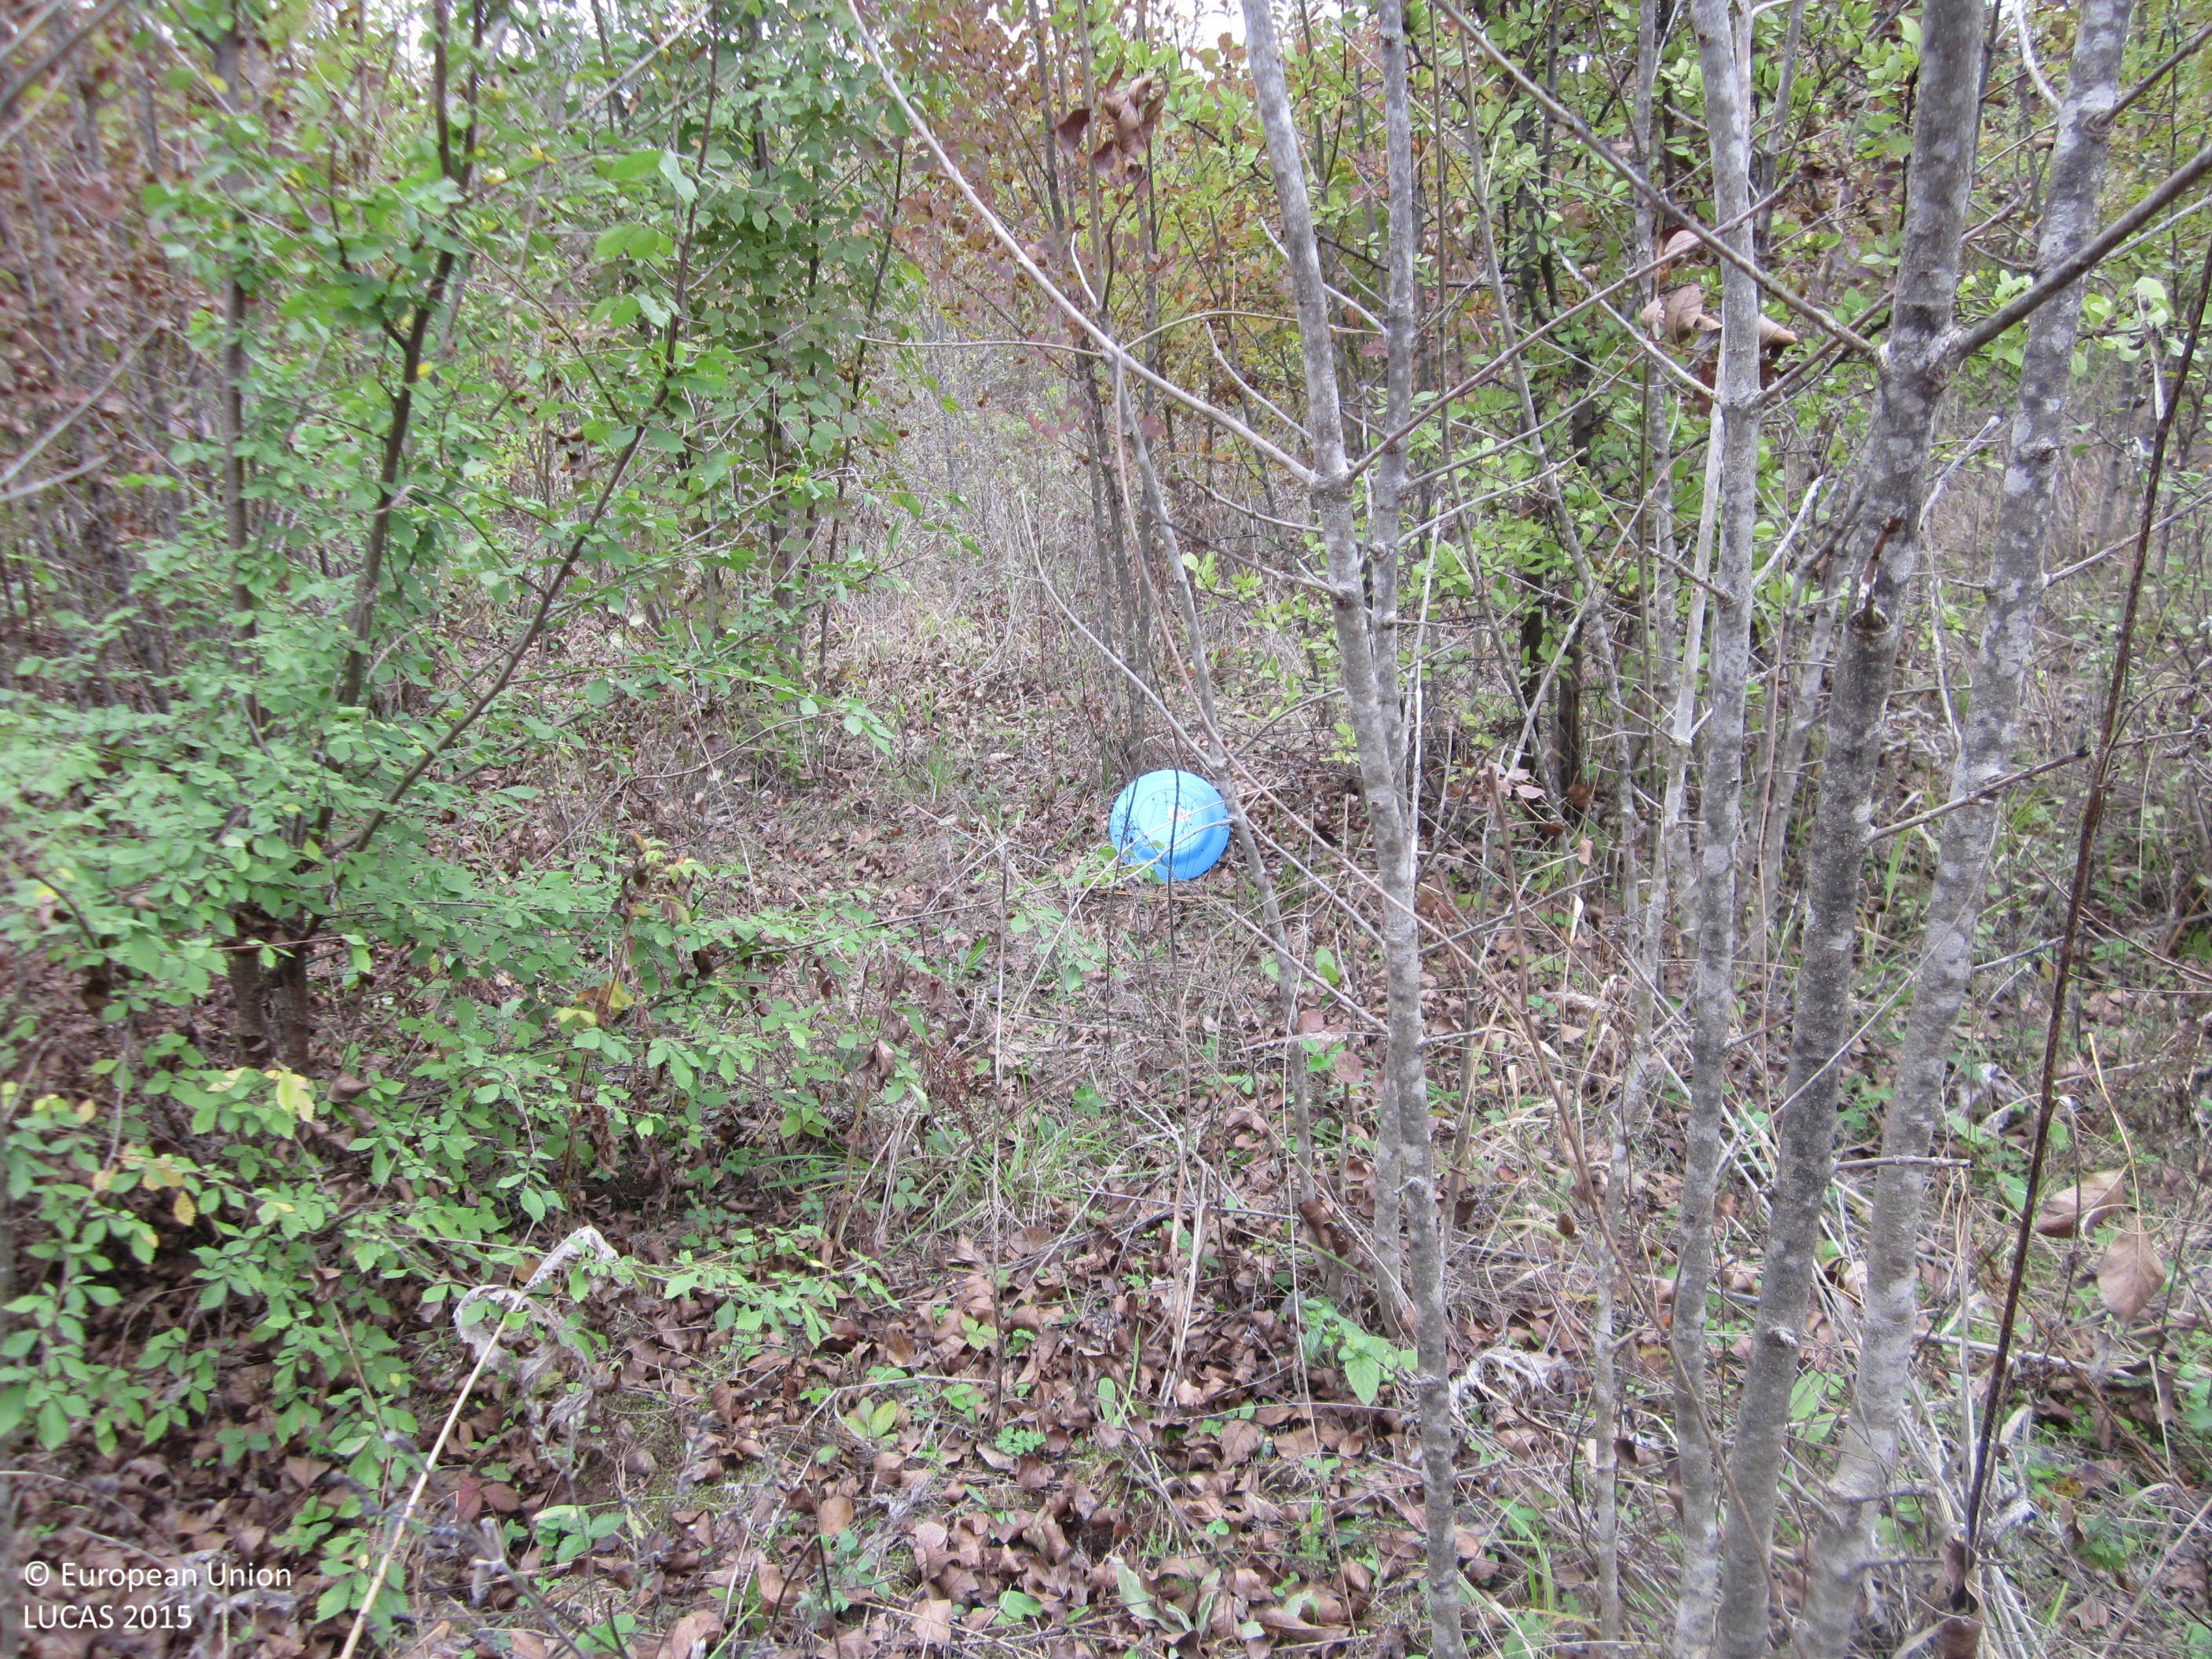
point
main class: Woodland
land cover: Broadleaved woodland
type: mesophytic deciduous forest
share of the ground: 50 - 75 %
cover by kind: broadleaved forest trees 70 %, shrubs 15 %, herbaceous plants 15 %
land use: Forestry
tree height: < 5 m
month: October
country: BG
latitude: 42.3074
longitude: 27.2252
